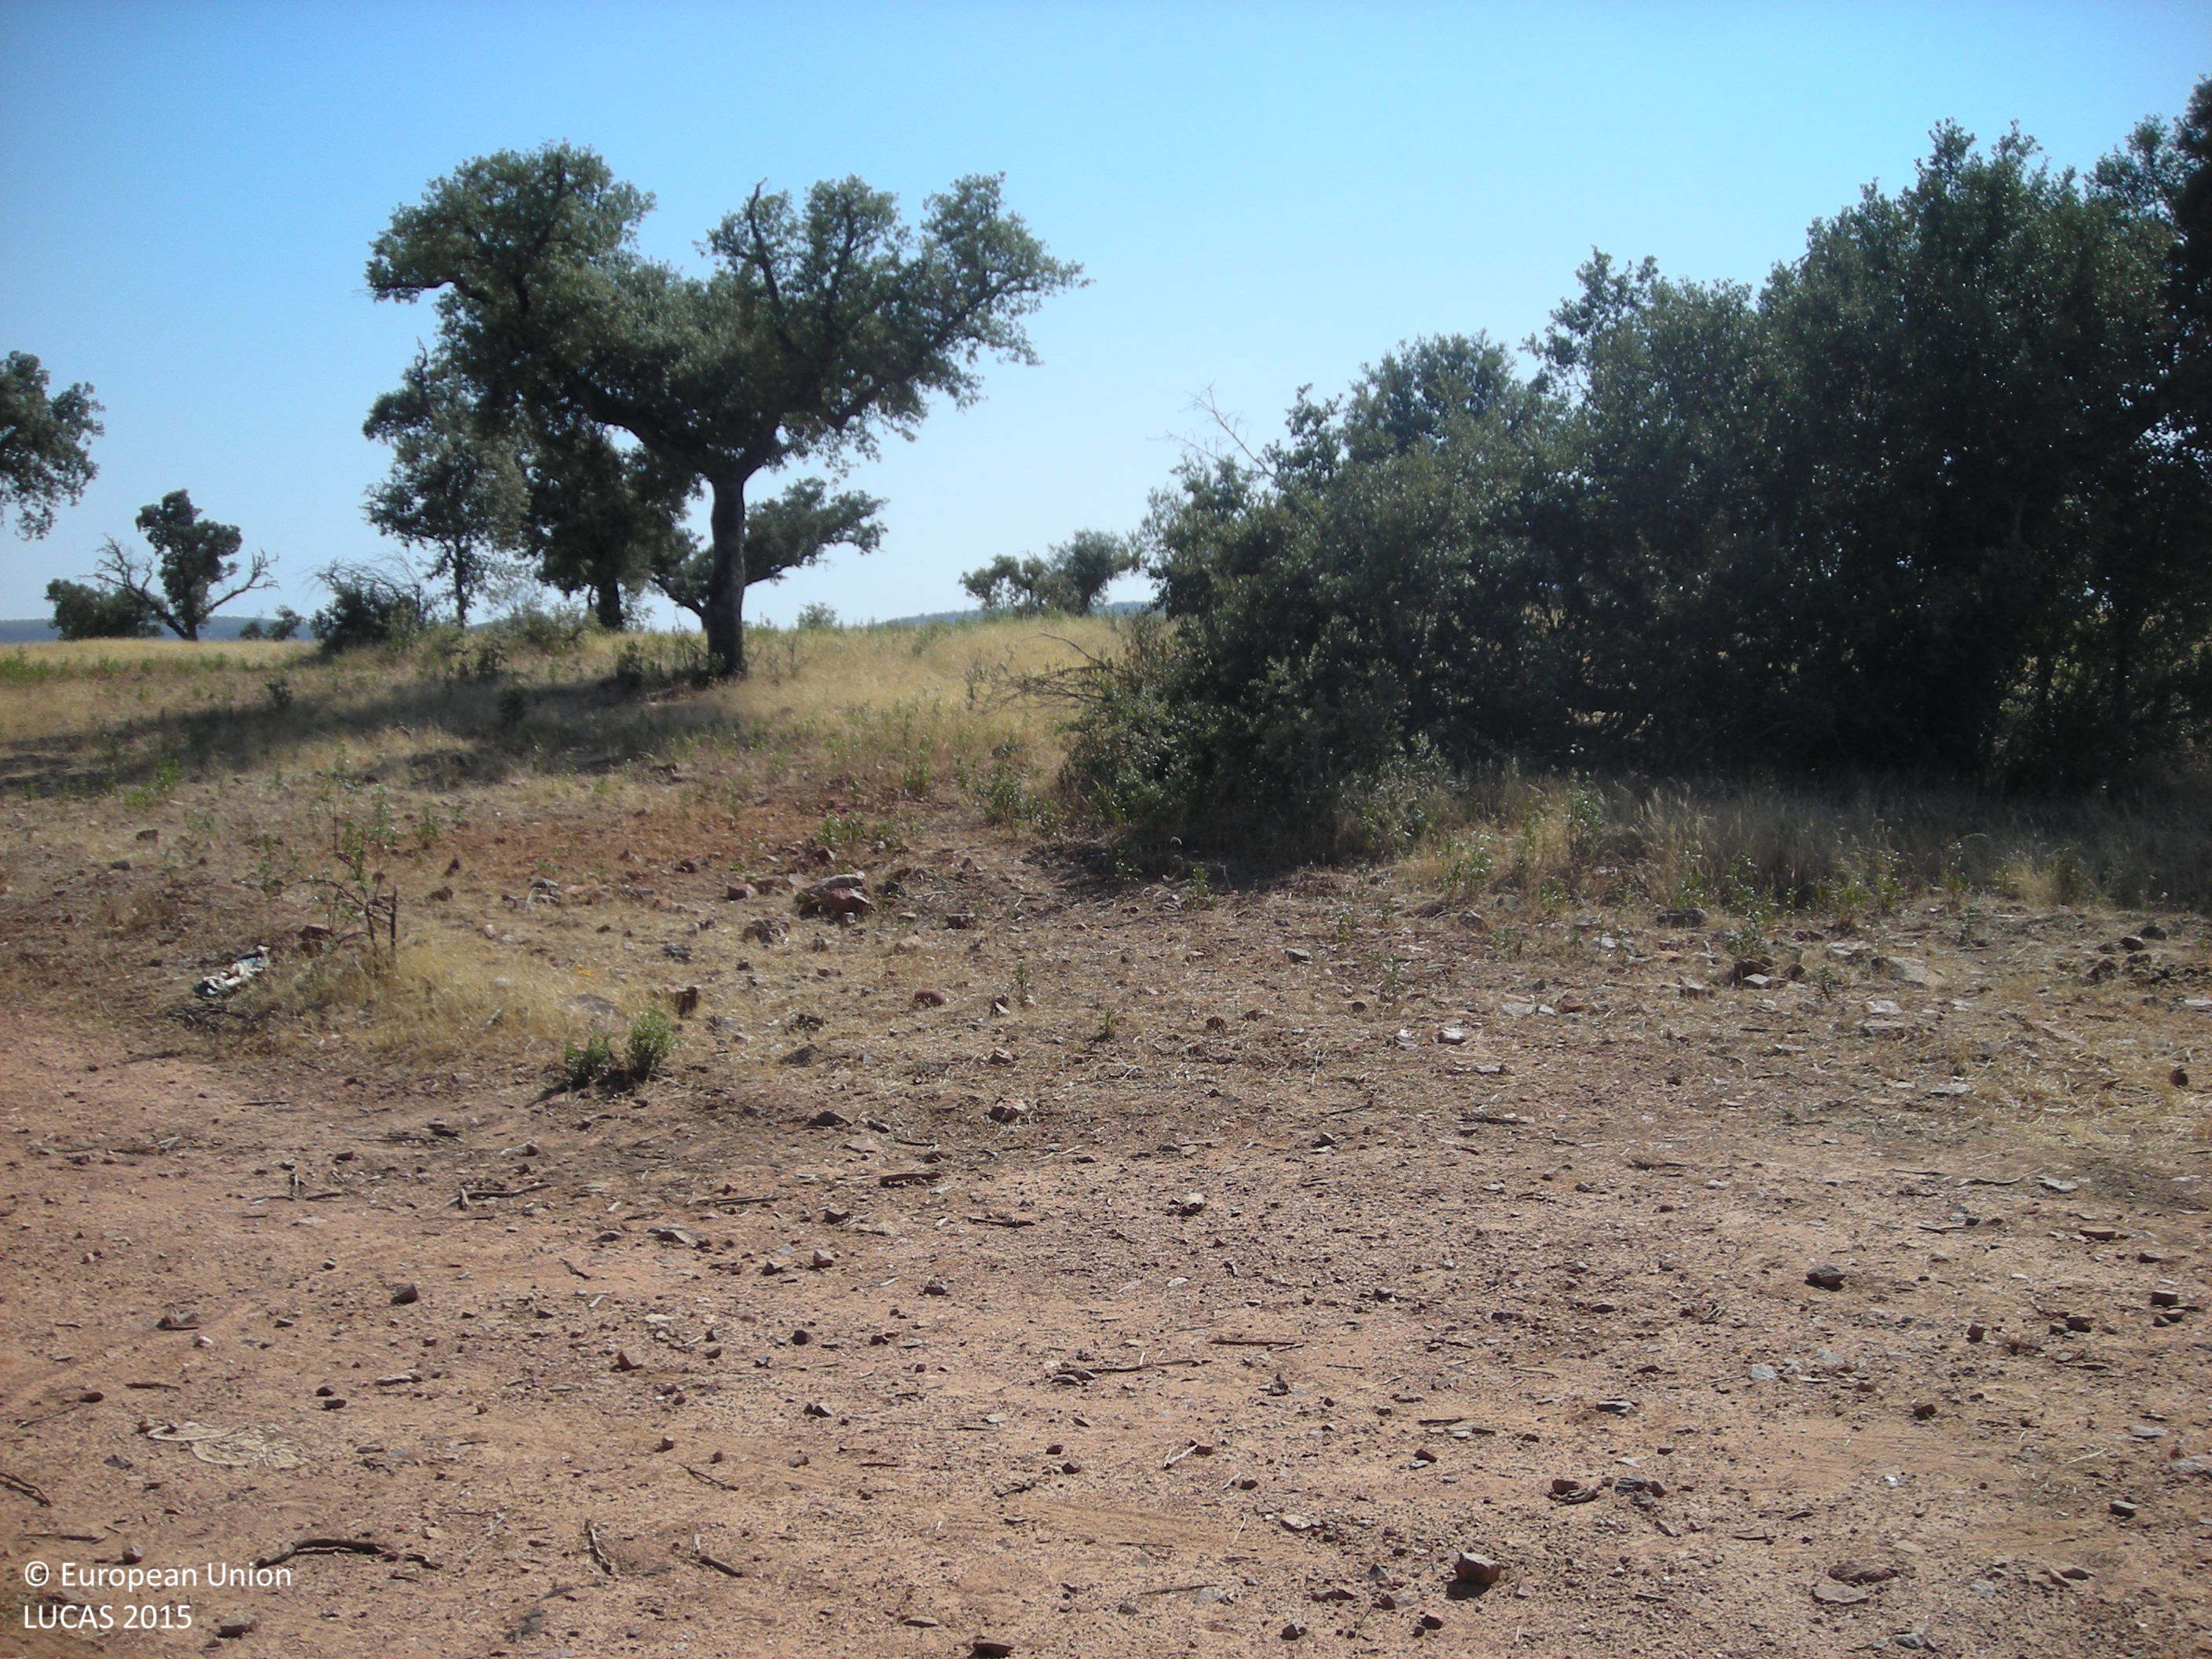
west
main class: Woodland
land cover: Broadleaved woodland
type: broadleaved evergreen forest
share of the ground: 10 - 25 %
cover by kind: unconsolidated bare surface 65 %, herbaceous plants 20 %, broadleaved forest trees 15 %
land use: Forestry
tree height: > 5 m
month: June
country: ES
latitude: 38.6046
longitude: -5.8320
